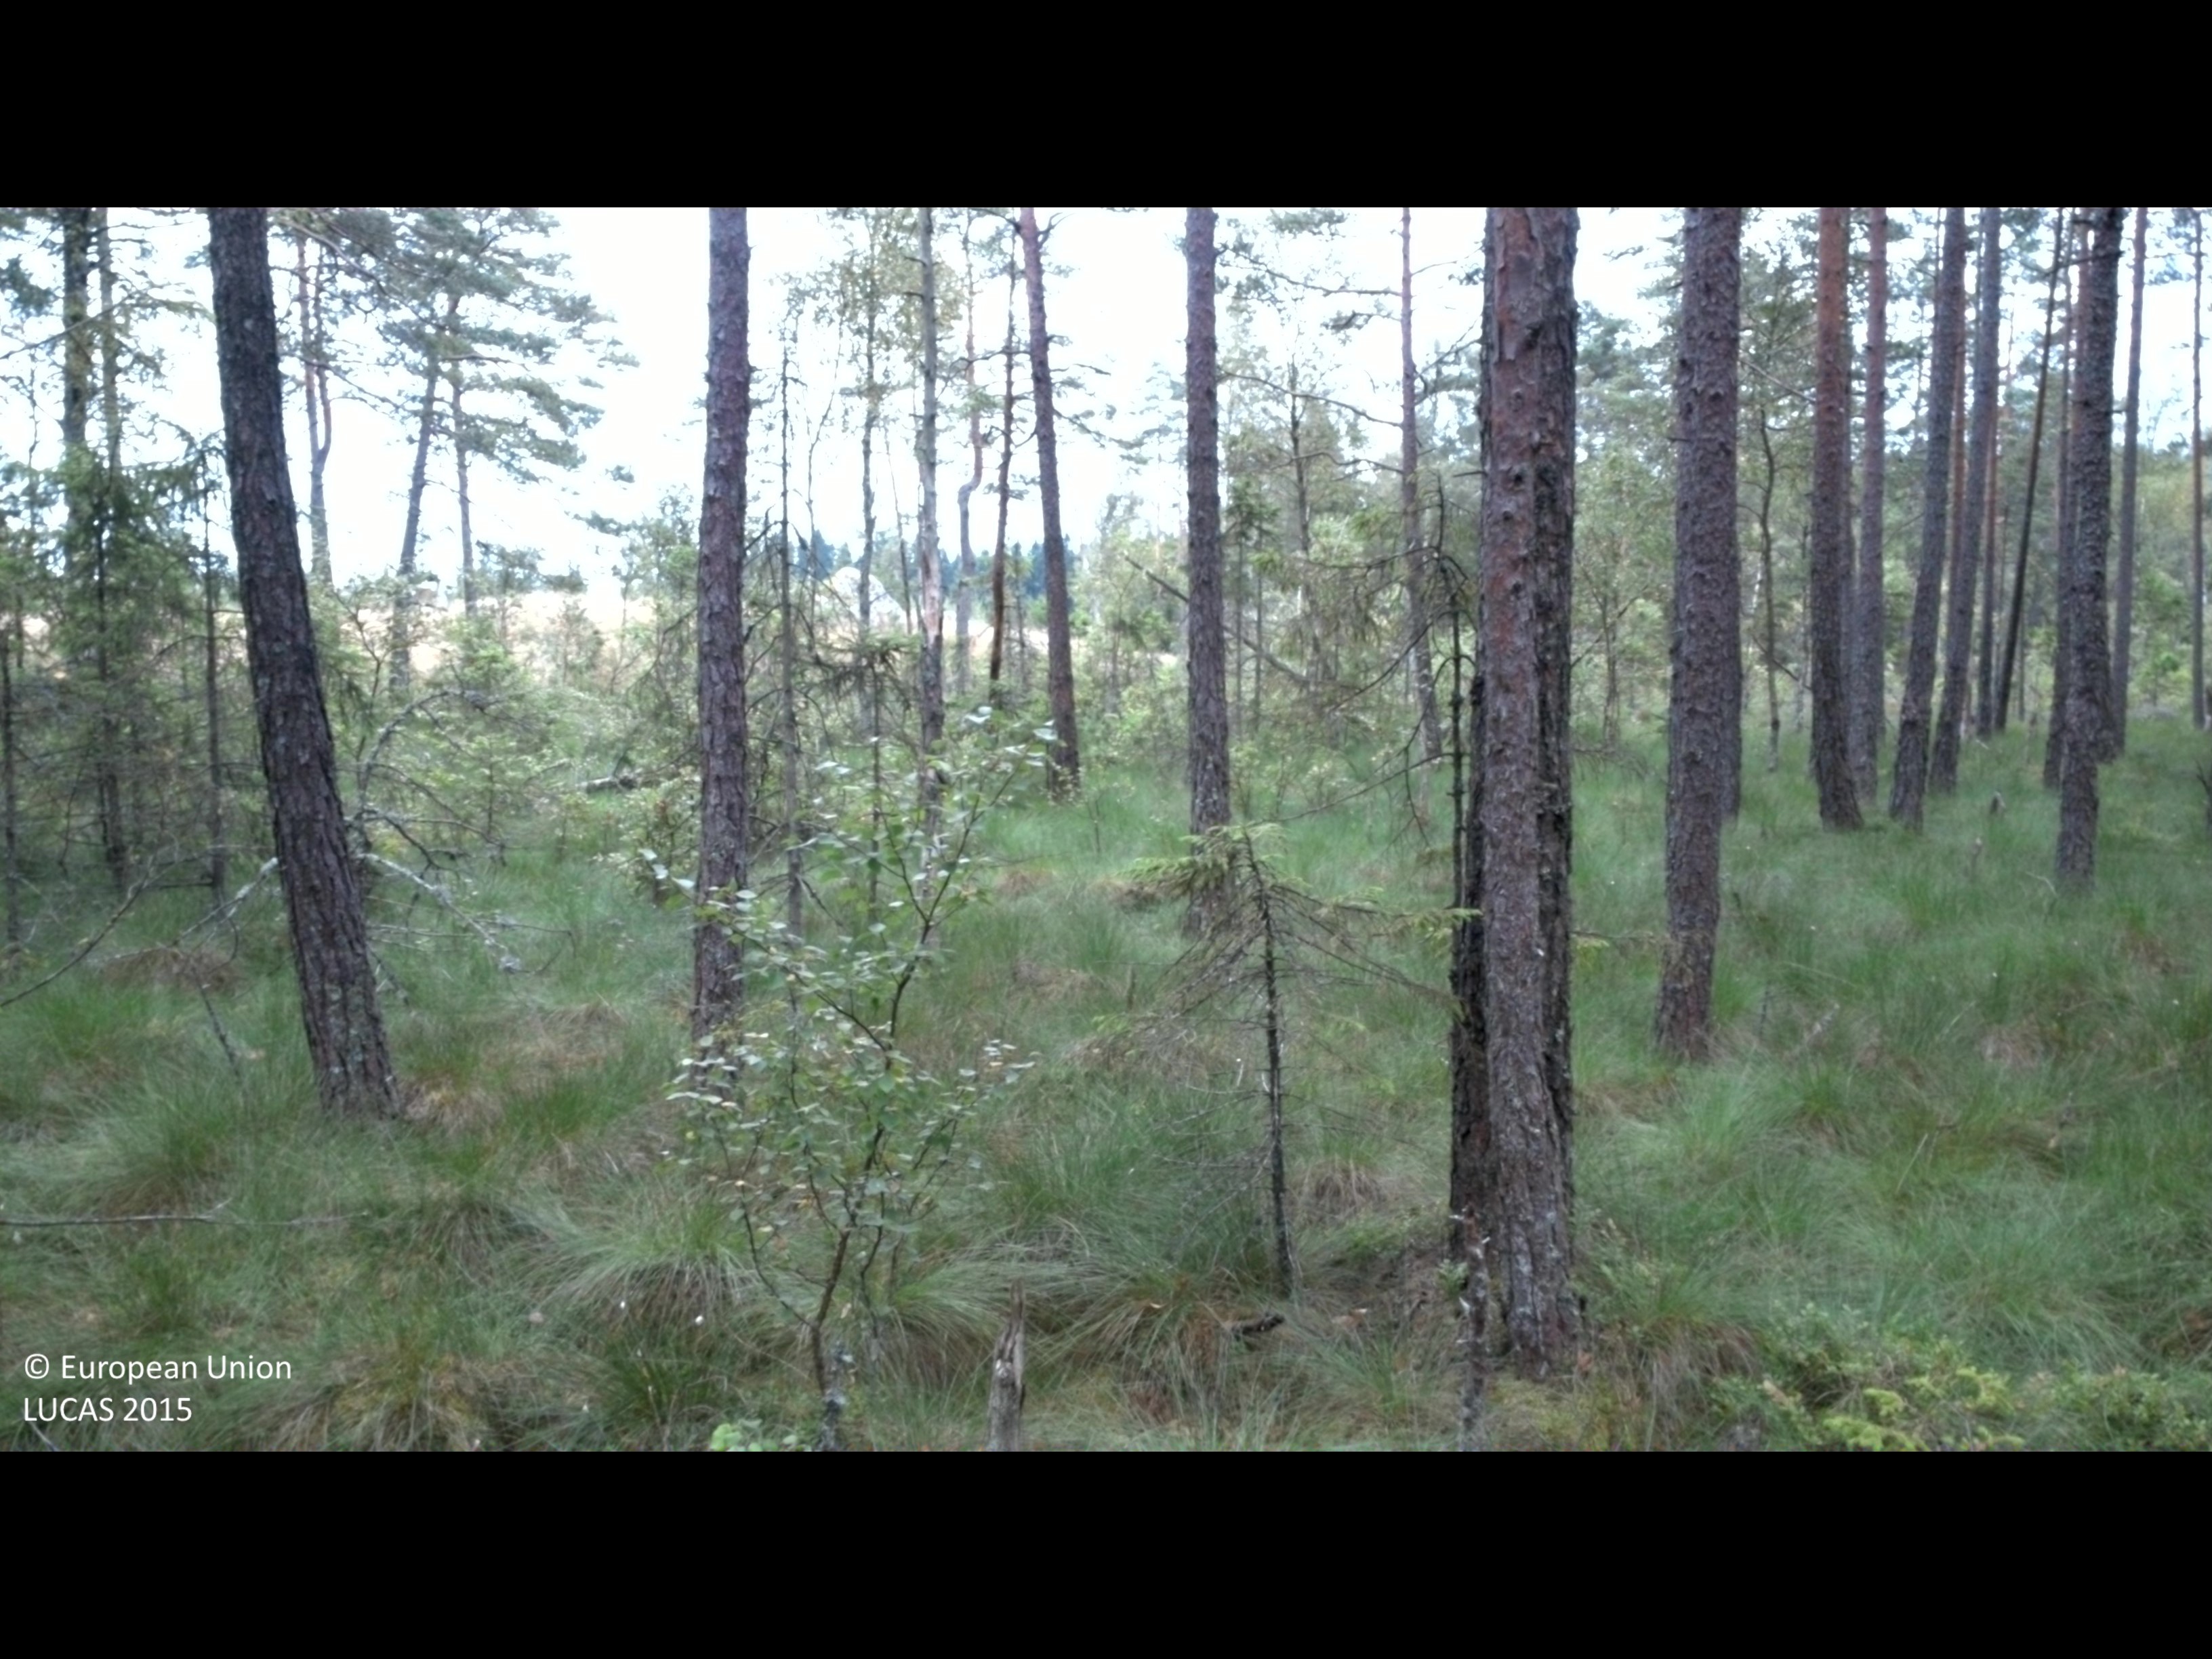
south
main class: Woodland
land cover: Pine dominated coniferous woodland
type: boreal forest
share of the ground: 50 - 75 %
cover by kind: coniferous forest trees 70 %, shrubs 30 %
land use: Forestry
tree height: > 5 m
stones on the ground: < 10 %
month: August
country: SE
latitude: 56.9044
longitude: 13.1657
